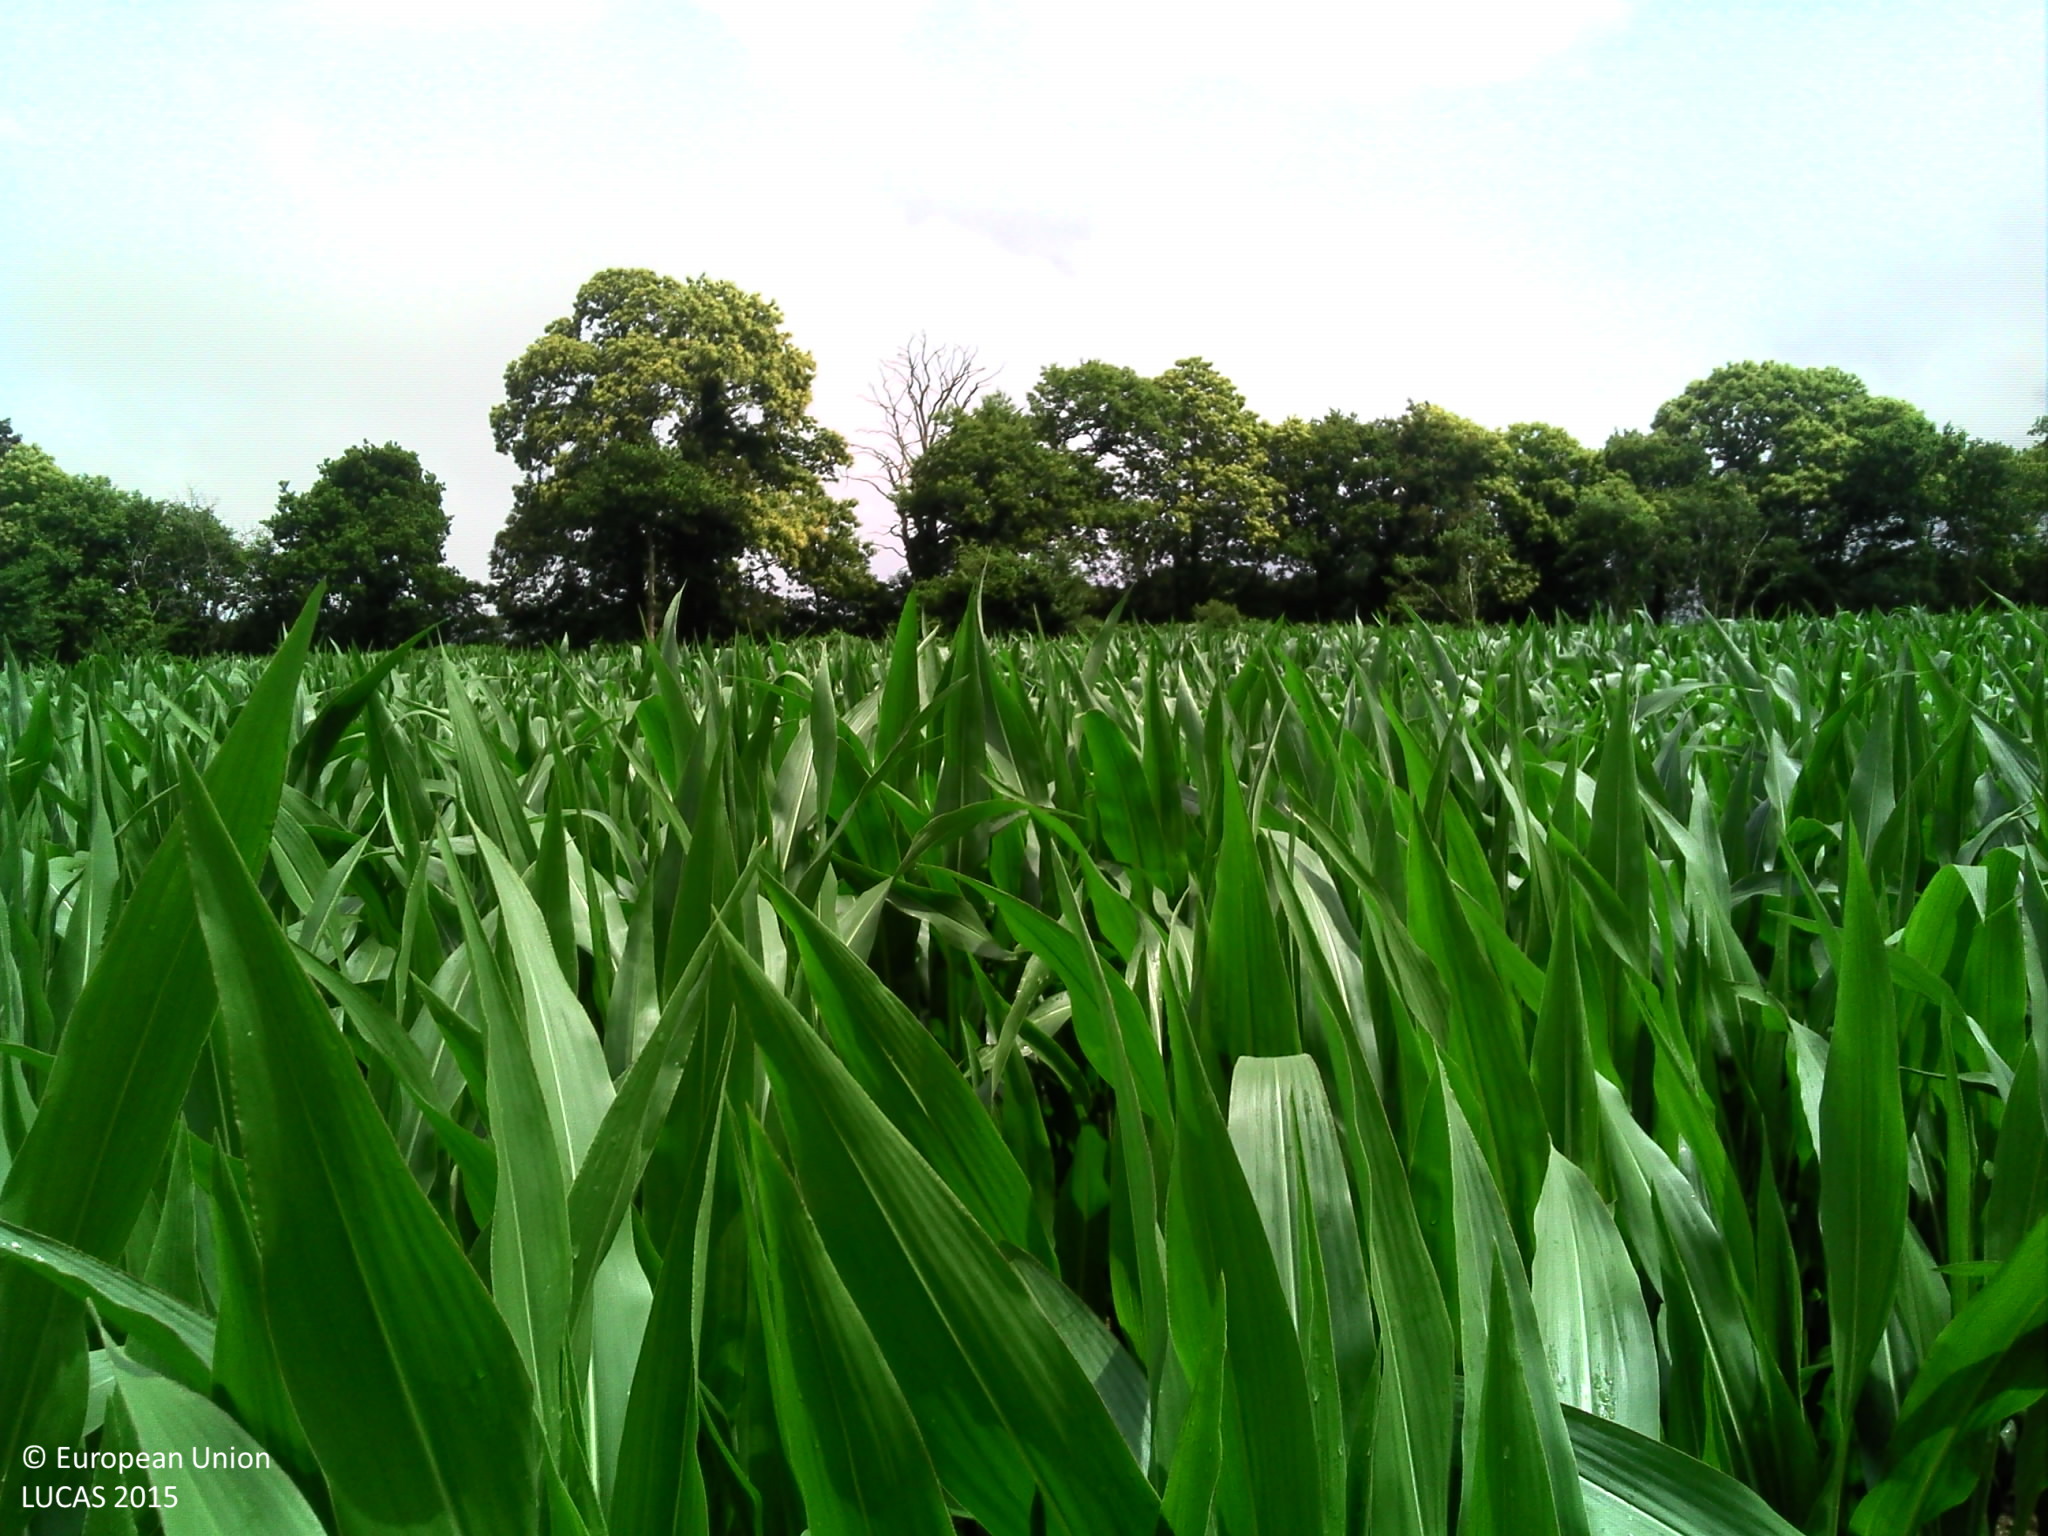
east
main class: Cropland
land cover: Maize
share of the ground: > 75 %
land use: Agriculture (excluding fallow land and kitchen gardens)
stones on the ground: < 10 %
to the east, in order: Maize; Lines of trees; Grass margins; Tracks; Grass margins; Lines of trees; Maize
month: July
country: FR
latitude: 48.6179
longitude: -3.4400
